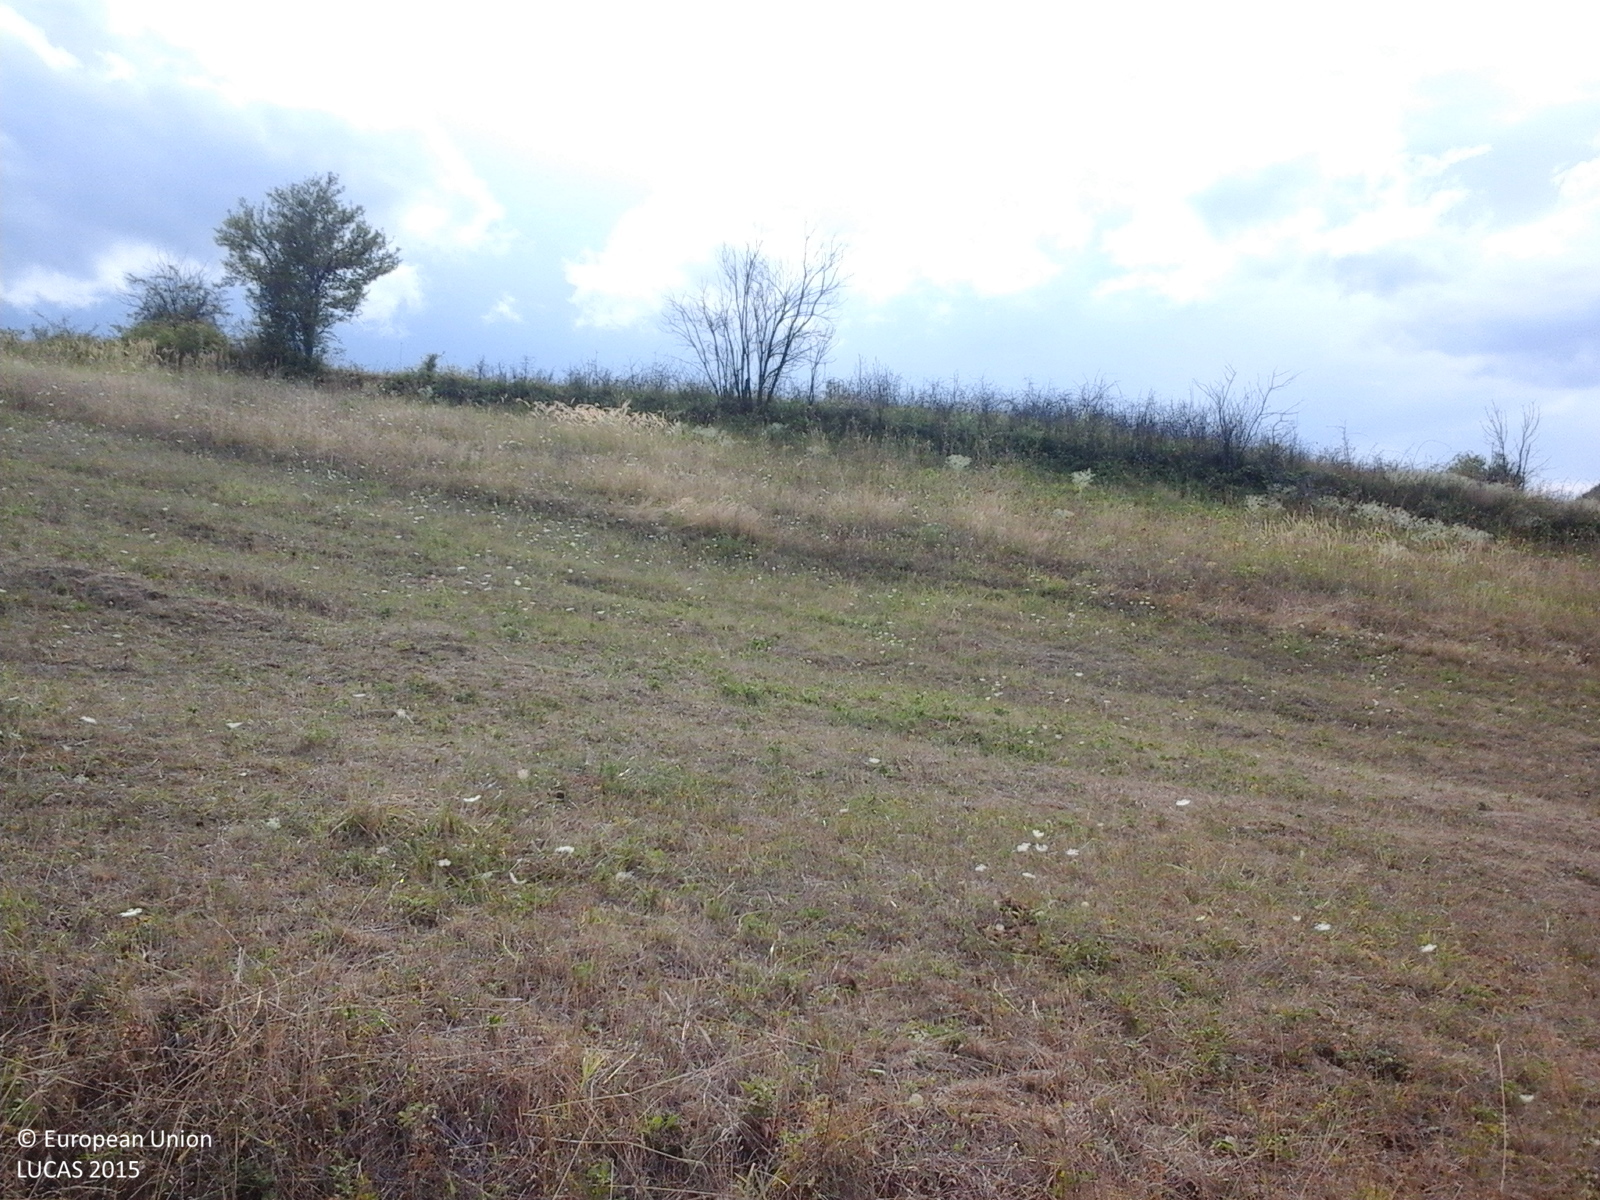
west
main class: Grassland
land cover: Grassland without tree/shrub cover
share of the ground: > 75 %
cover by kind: herbaceous plants 100 %
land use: Agriculture (excluding fallow land and kitchen gardens)
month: August
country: RO
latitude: 44.6404
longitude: 22.8662
